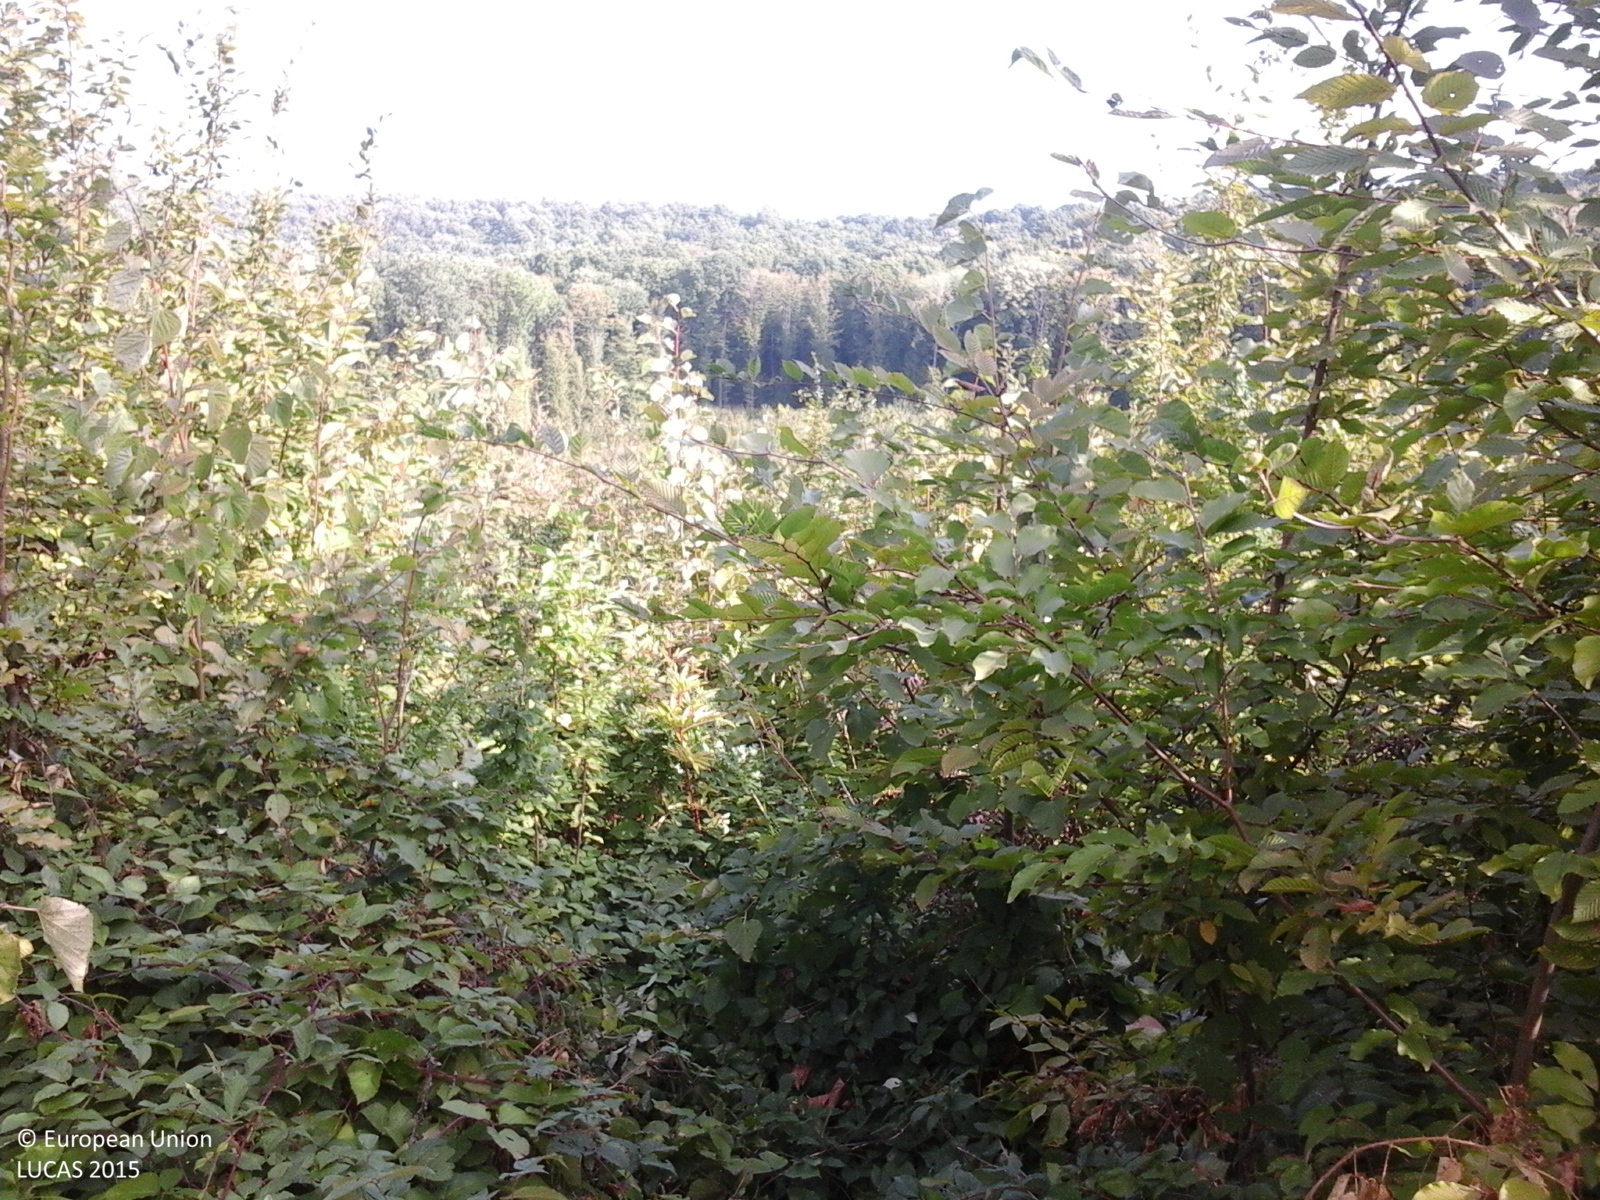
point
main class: Woodland
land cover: Broadleaved woodland
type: acidophilous oak and oak-birch forest
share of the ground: > 75 %
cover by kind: broadleaved forest trees 95 %, herbaceous plants 5 %
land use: Forestry
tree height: < 5 m
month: September
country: RO
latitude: 45.4761
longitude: 22.1287
